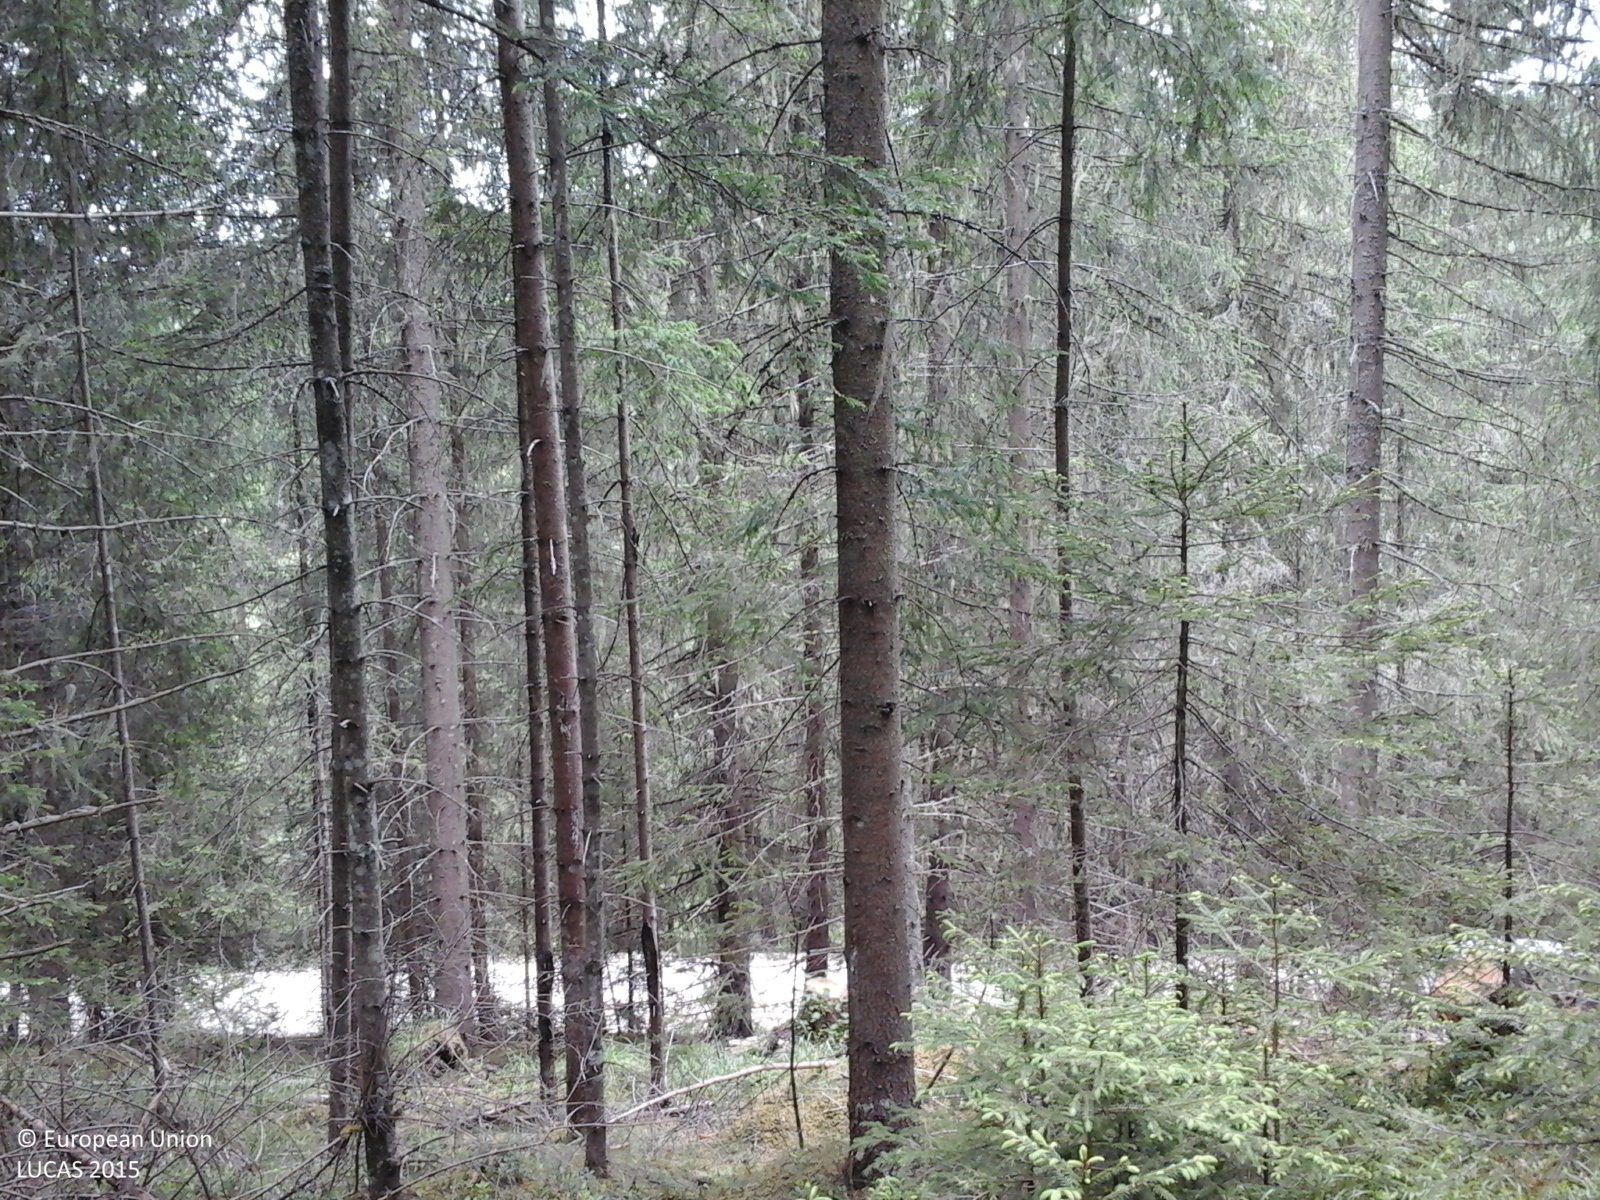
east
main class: Woodland
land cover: Spruce dominated coniferous woodland
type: alpine coniferous forest
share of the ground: > 75 %
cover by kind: coniferous forest trees 100 %
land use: Forestry
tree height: > 5 m
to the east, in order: Spruce dominated coniferous woodland; Tracks; Spruce dominated coniferous woodland; Grassland with sparse tree/shrub cover; Spruce dominated coniferous woodland; Inland fresh running water; Spruce dominated coniferous woodland
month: June
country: RO
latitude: 47.1480
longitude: 25.4225
